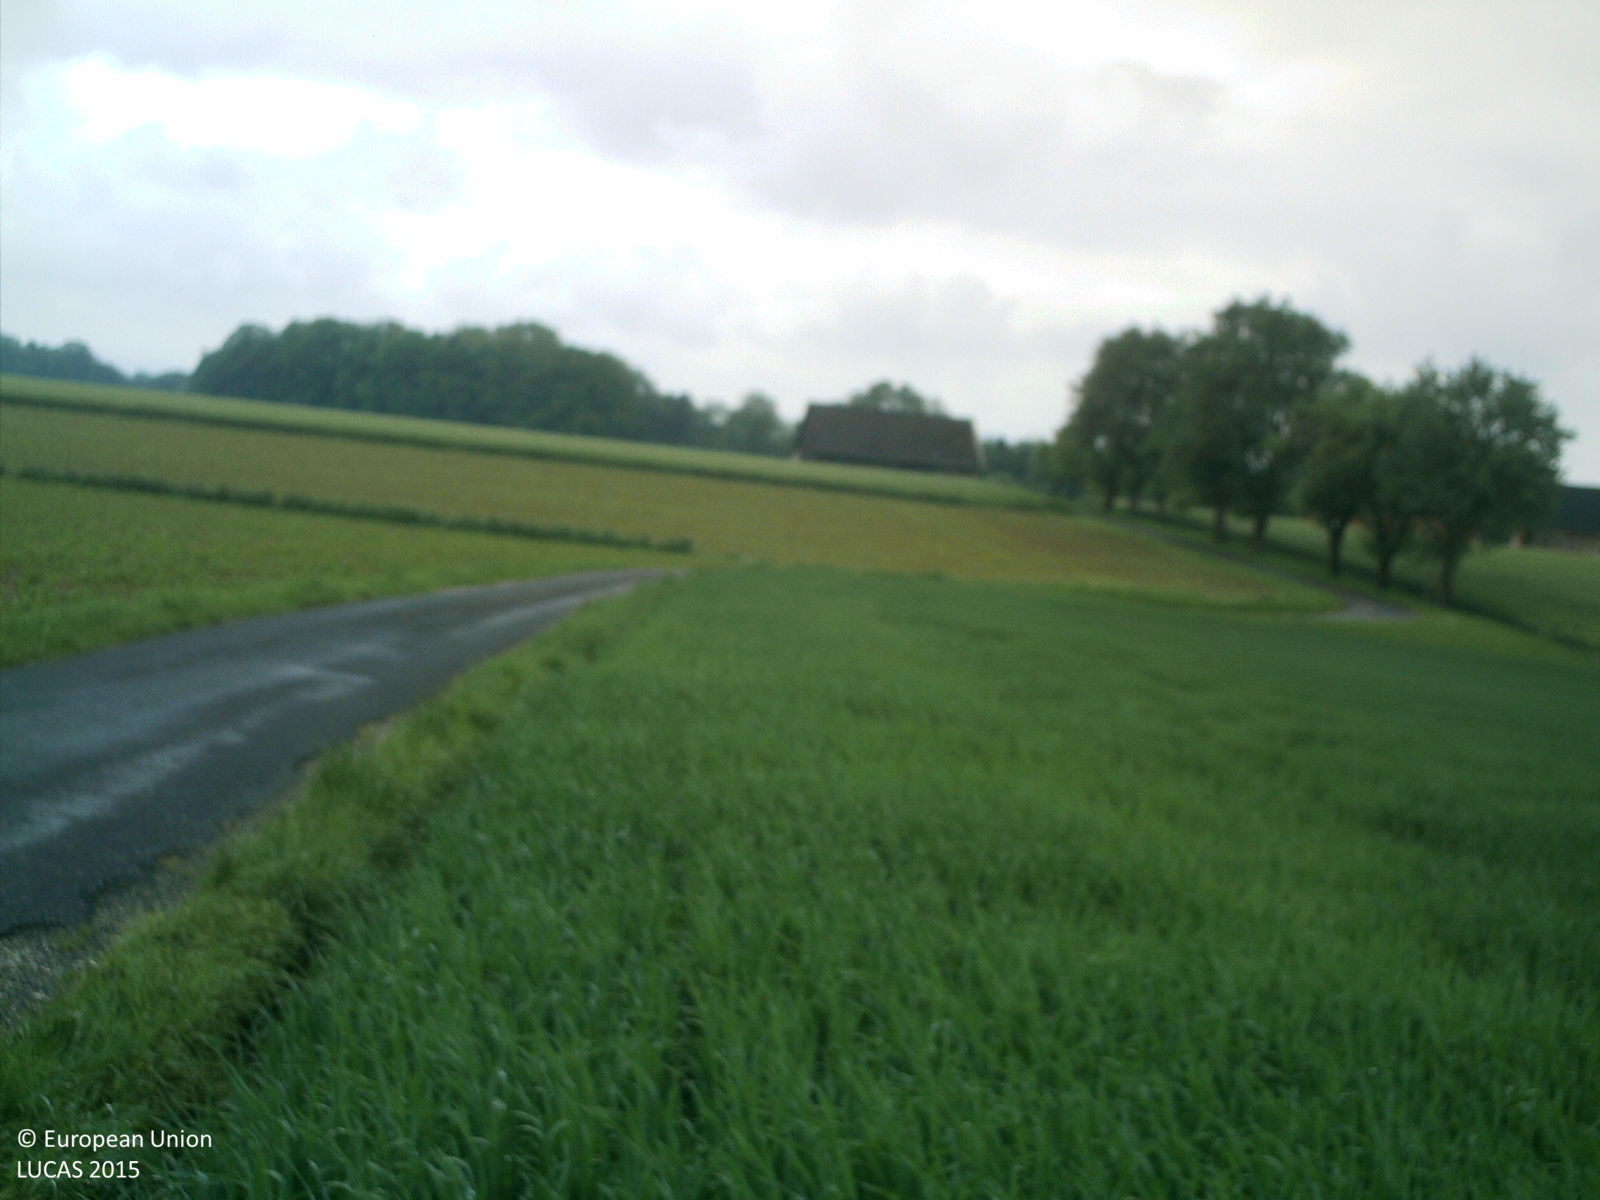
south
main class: Cropland
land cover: Oats
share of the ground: > 75 %
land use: Agriculture (excluding fallow land and kitchen gardens)
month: May
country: AT
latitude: 48.0874
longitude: 14.2556
